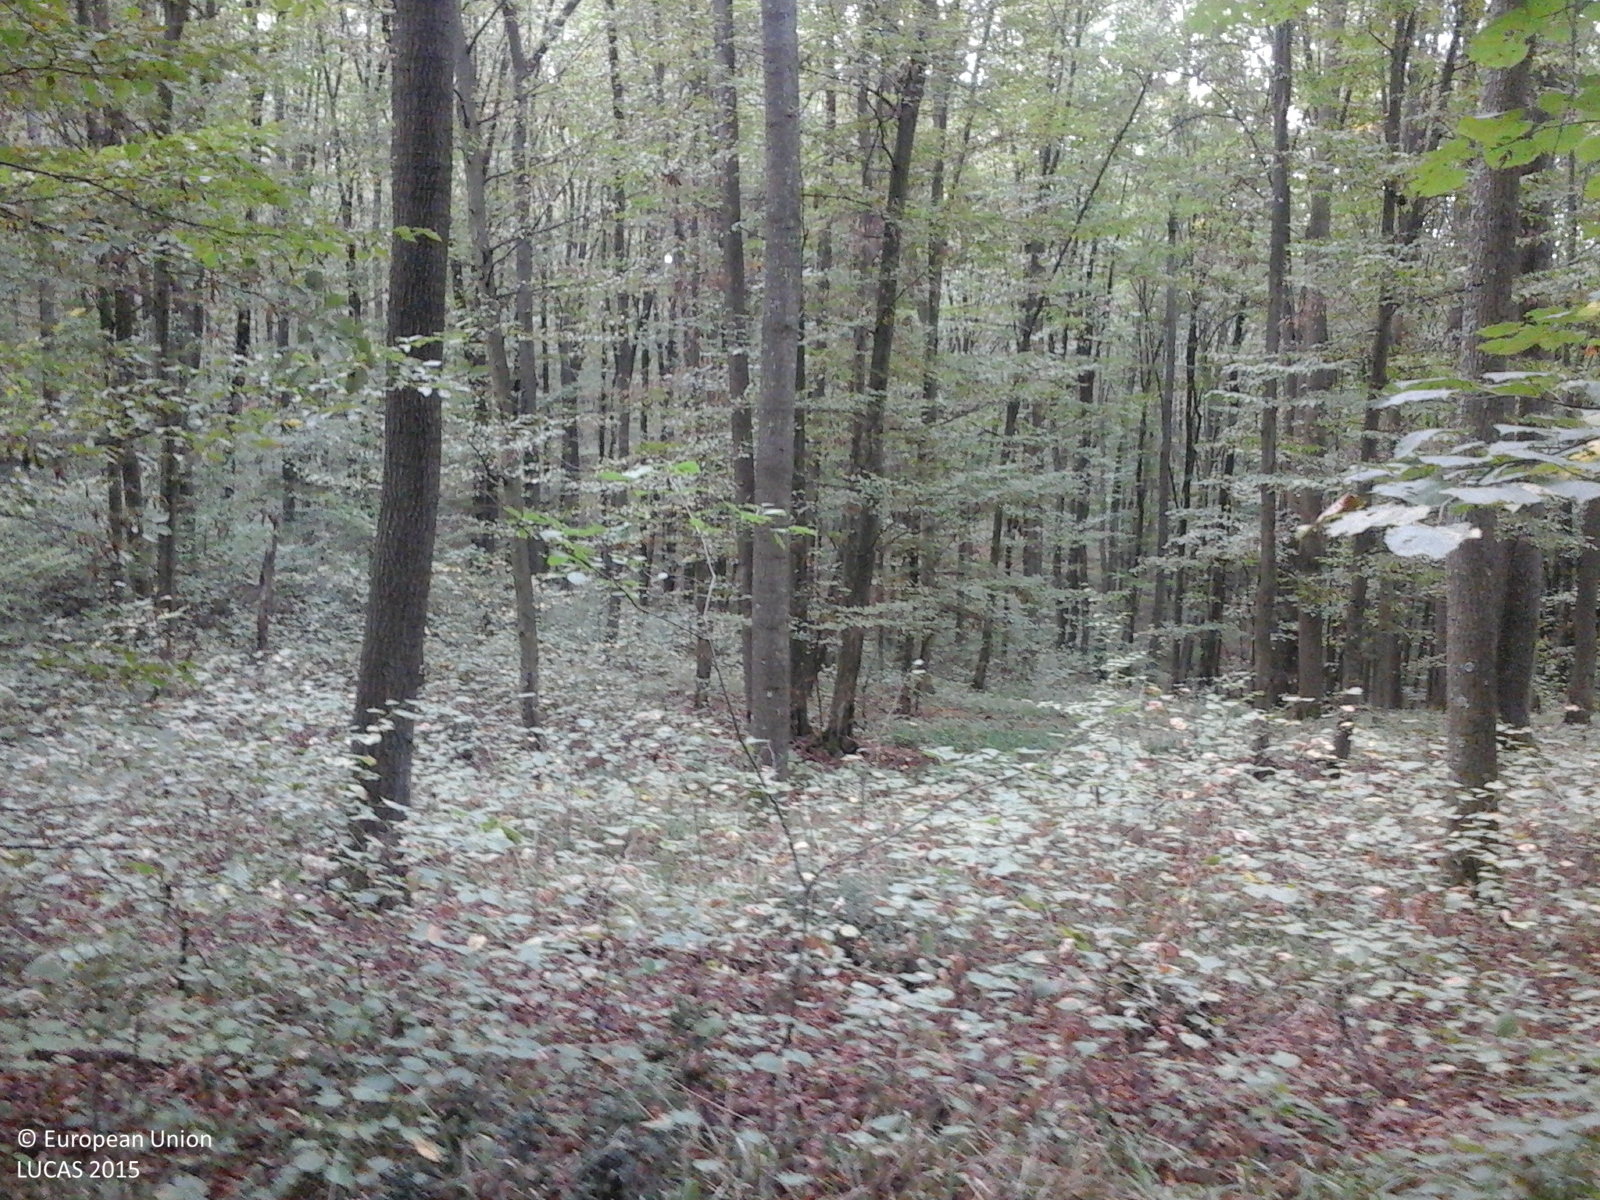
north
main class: Woodland
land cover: Broadleaved woodland
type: mesophytic deciduous forest
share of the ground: > 75 %
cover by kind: broadleaved forest trees 100 %
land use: Forestry
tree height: > 5 m
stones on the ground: 10 - 25 %
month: September
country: RO
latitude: 45.9049
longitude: 22.1993
